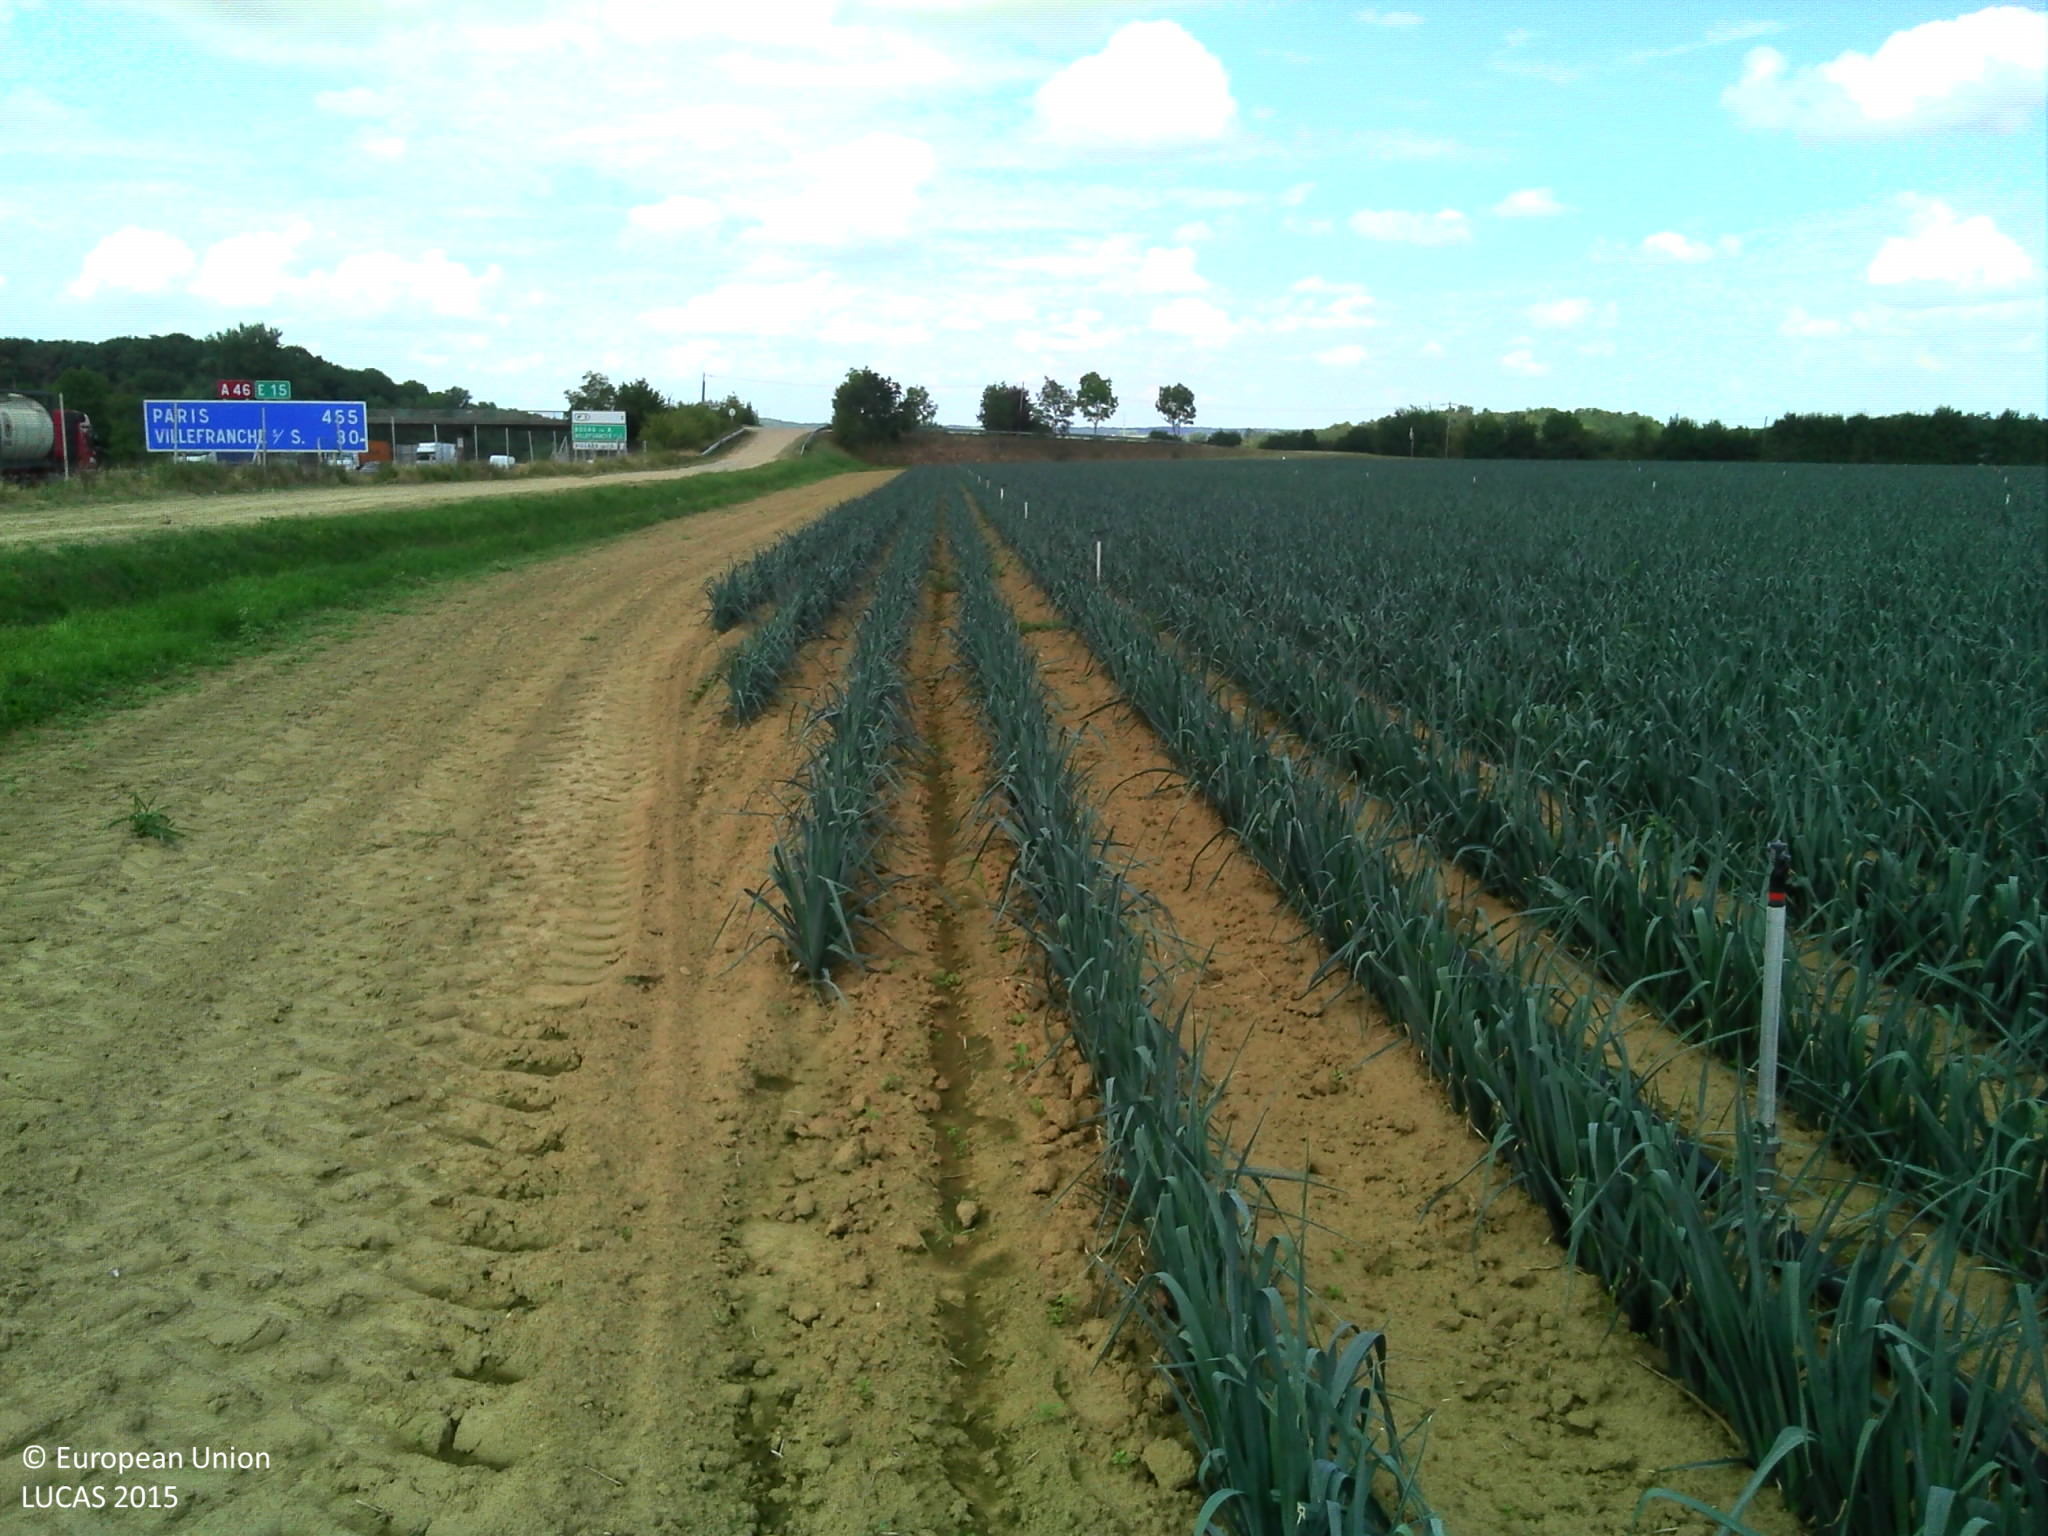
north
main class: Cropland
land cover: Other fresh vegetables
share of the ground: 10 - 25 %
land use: Agriculture (excluding fallow land and kitchen gardens)
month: August
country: FR
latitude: 45.8334
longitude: 4.9183
